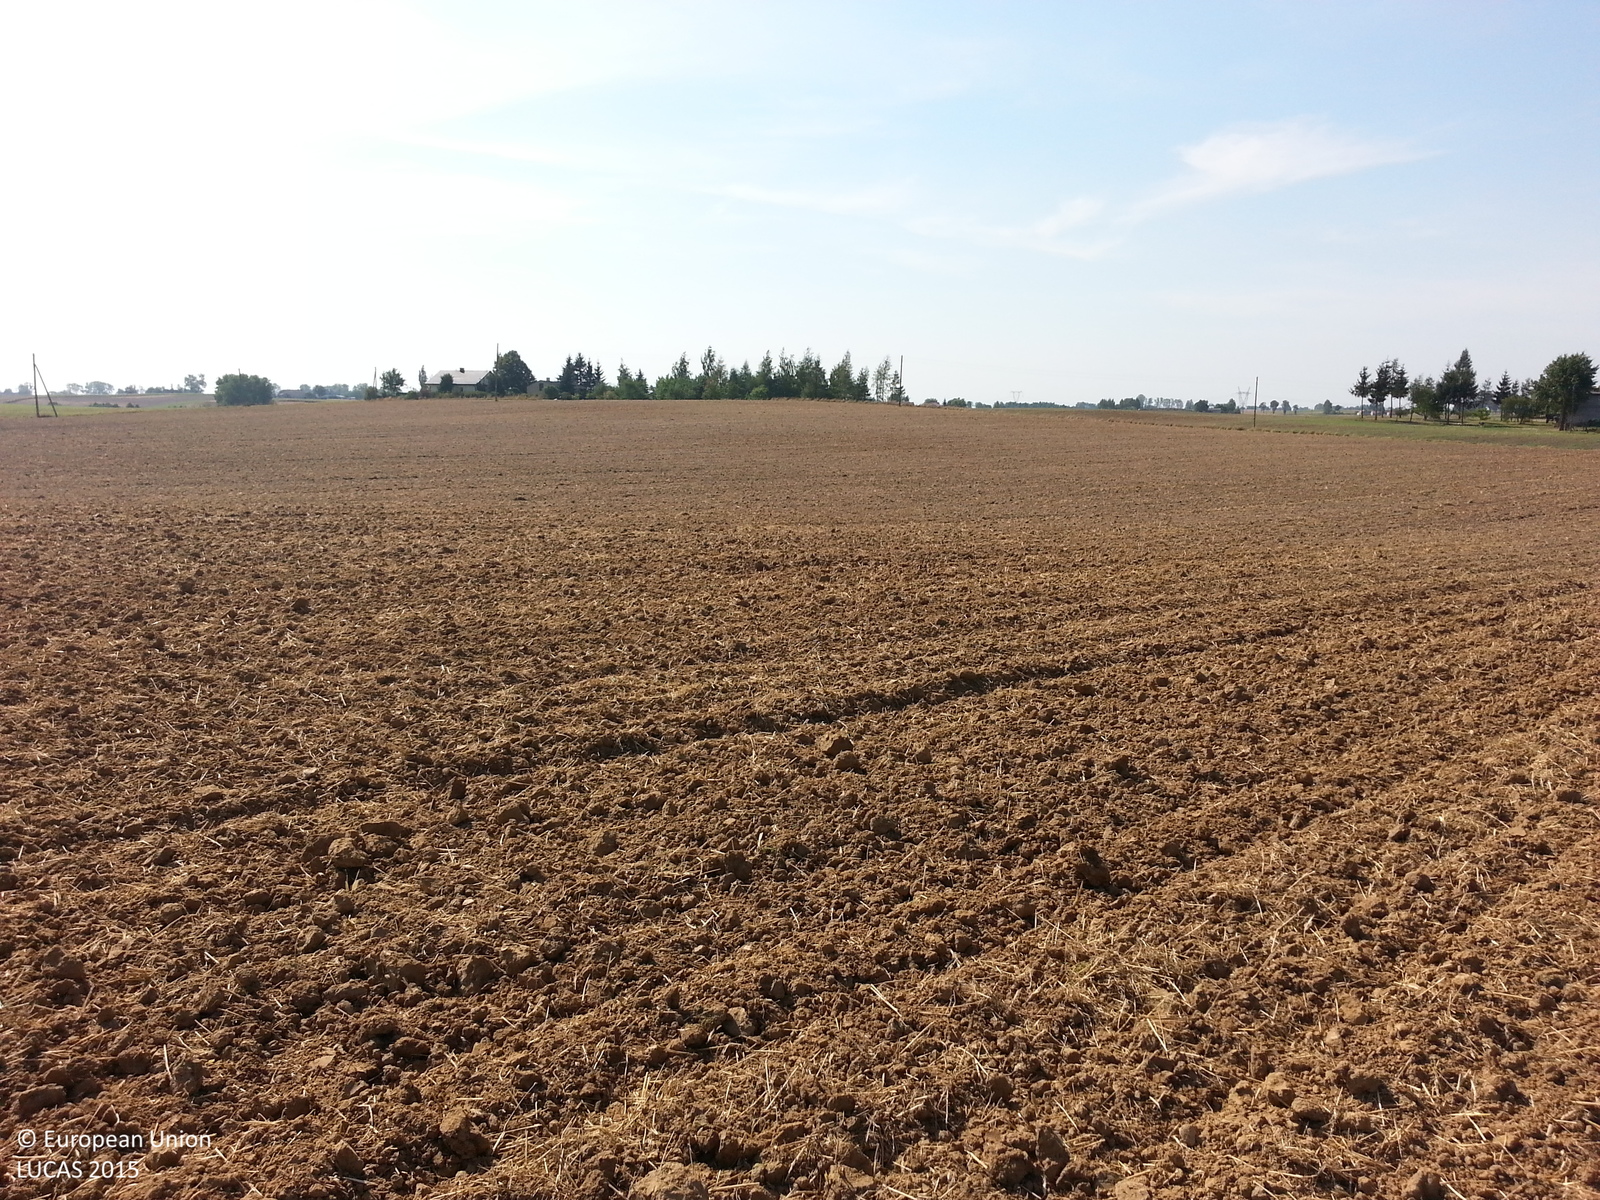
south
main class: Cropland
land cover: Triticale
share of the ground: > 75 %
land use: Agriculture (excluding fallow land and kitchen gardens)
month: August
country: PL
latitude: 53.0913
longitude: 19.1474
